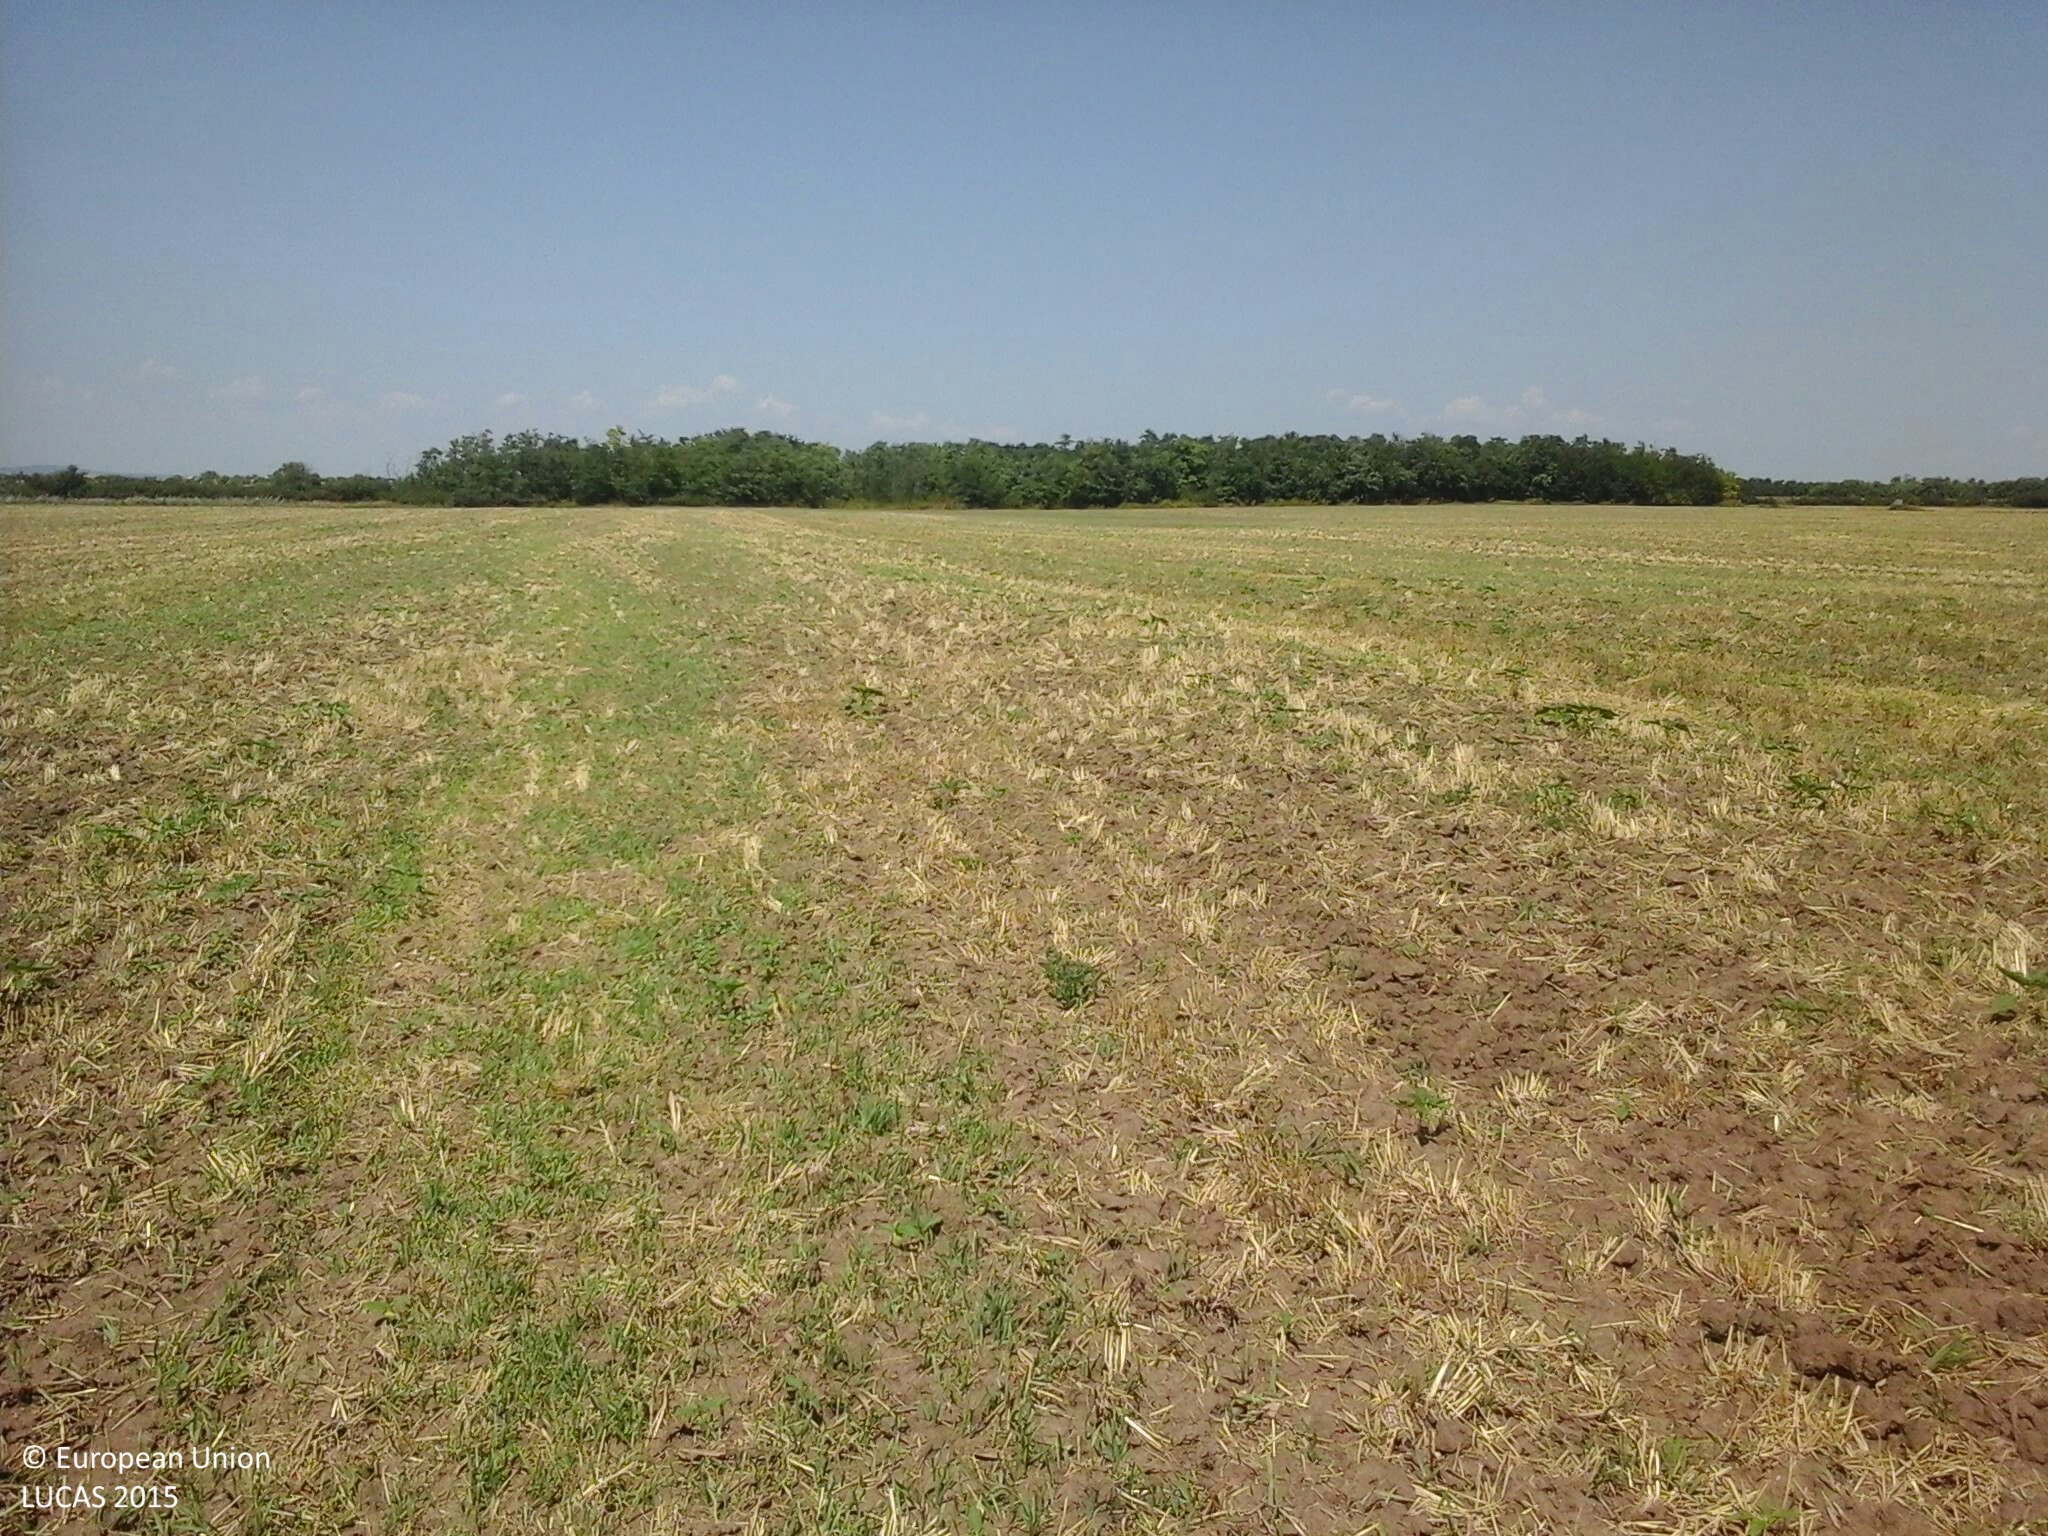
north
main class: Cropland
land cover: Common wheat
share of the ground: < 10 %
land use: Agriculture (excluding fallow land and kitchen gardens)
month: July
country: HU
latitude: 47.0823
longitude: 18.2429
